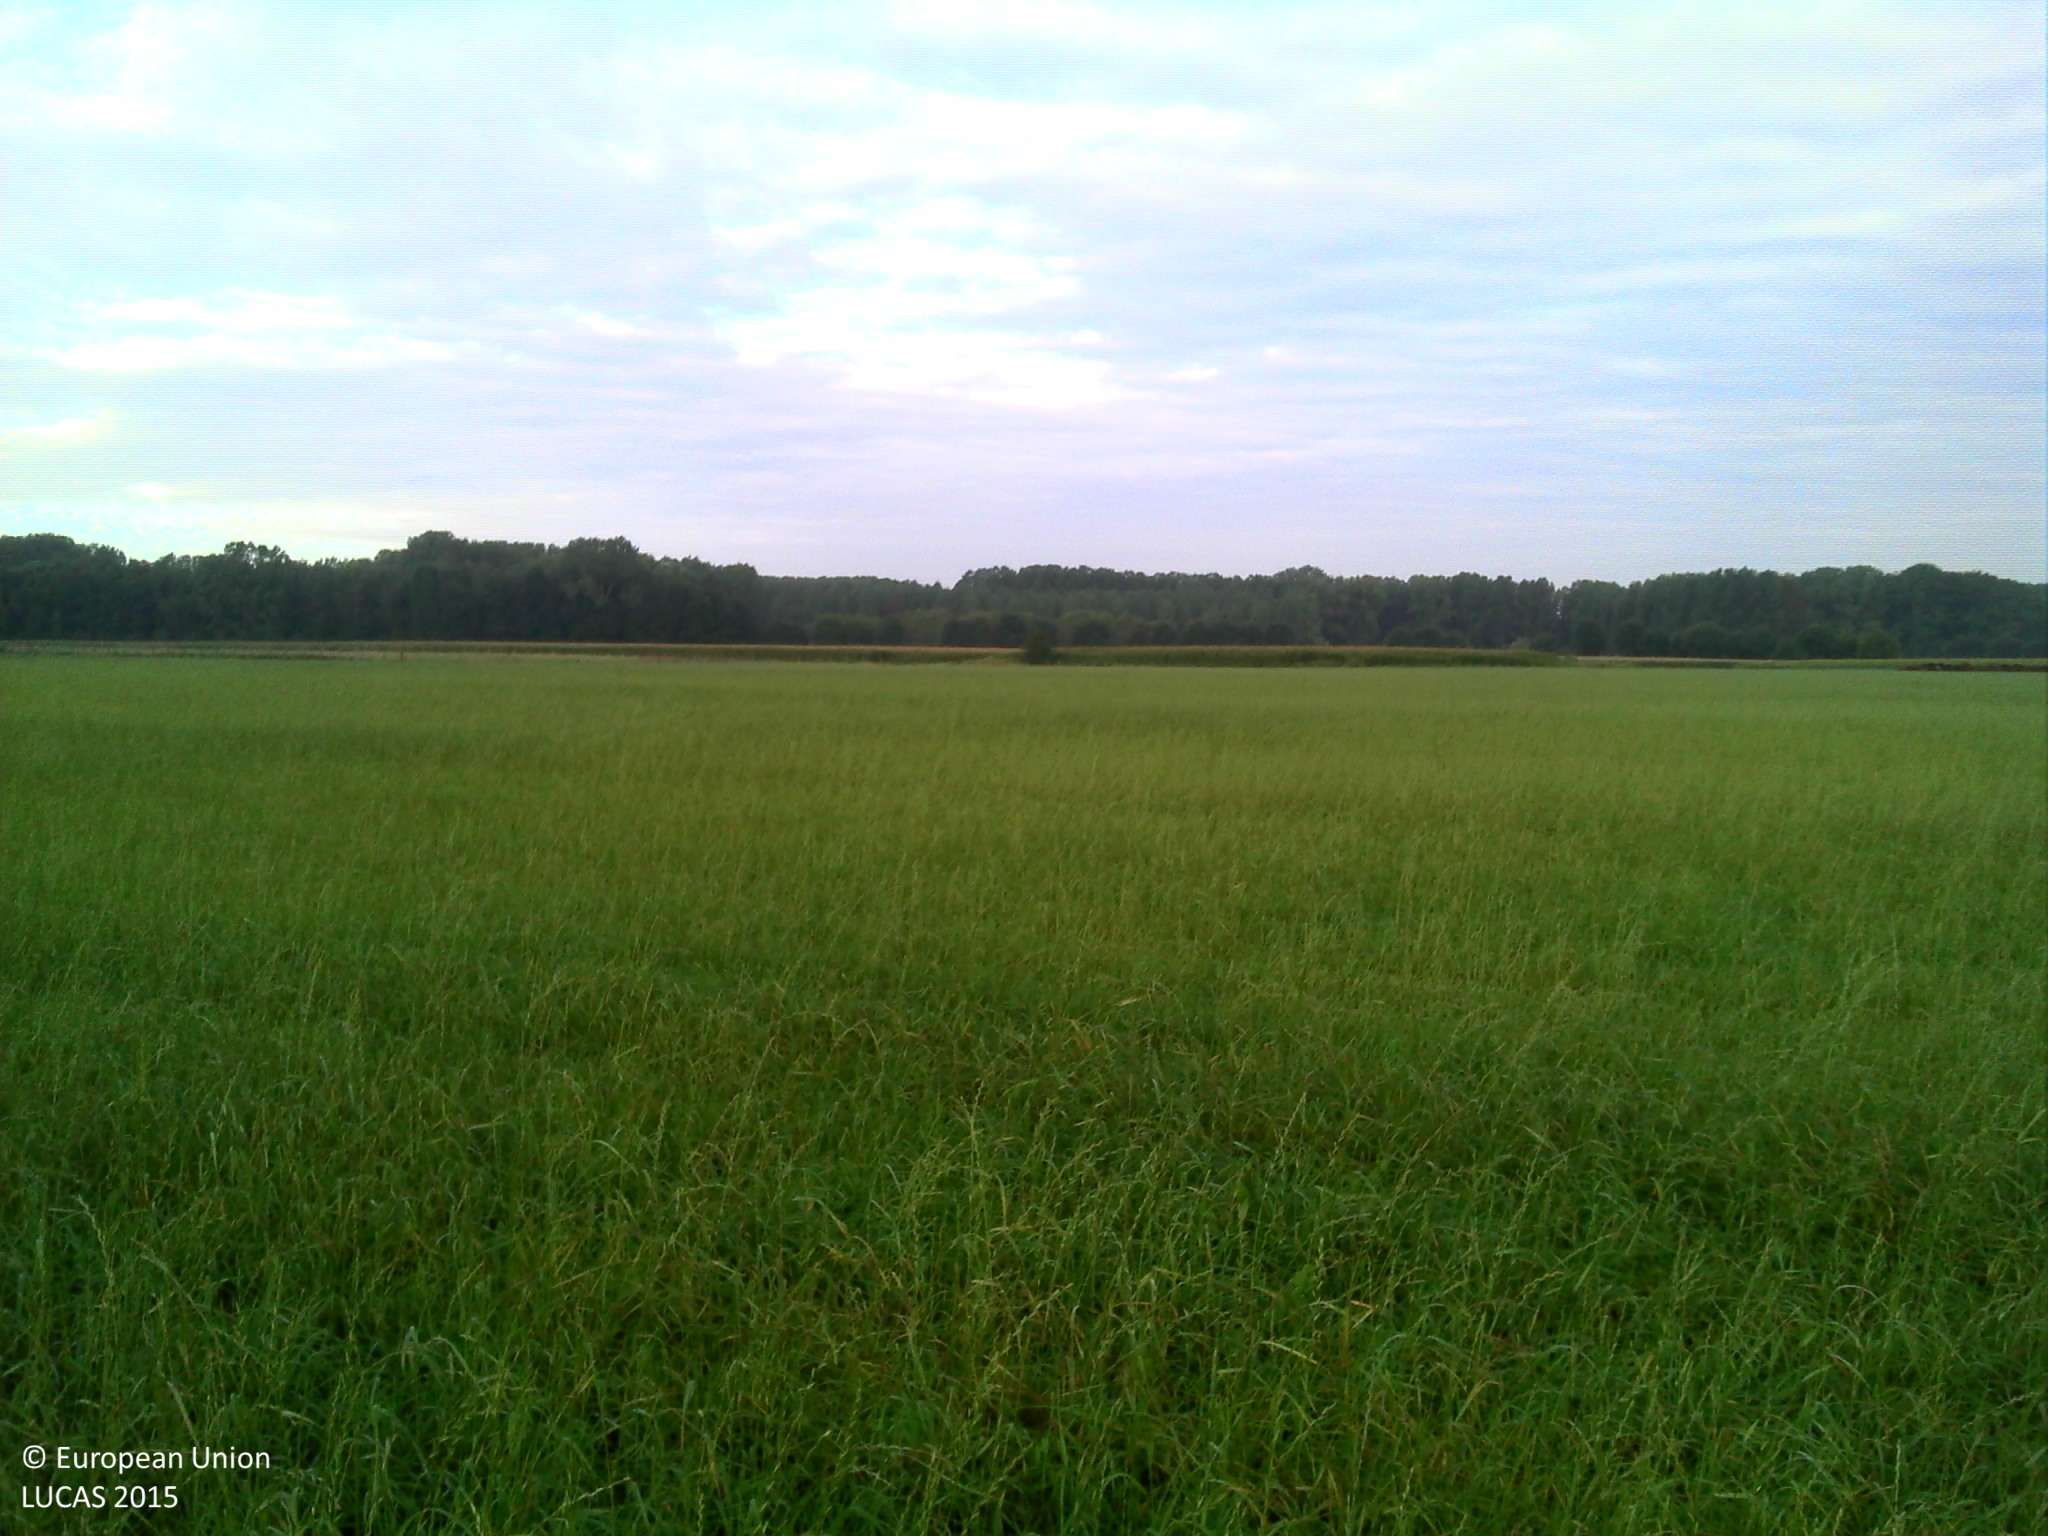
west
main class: Cropland
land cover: Temporary grasslands
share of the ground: > 75 %
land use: Agriculture (excluding fallow land and kitchen gardens)
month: September
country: BE
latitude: 51.0499
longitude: 4.2748
